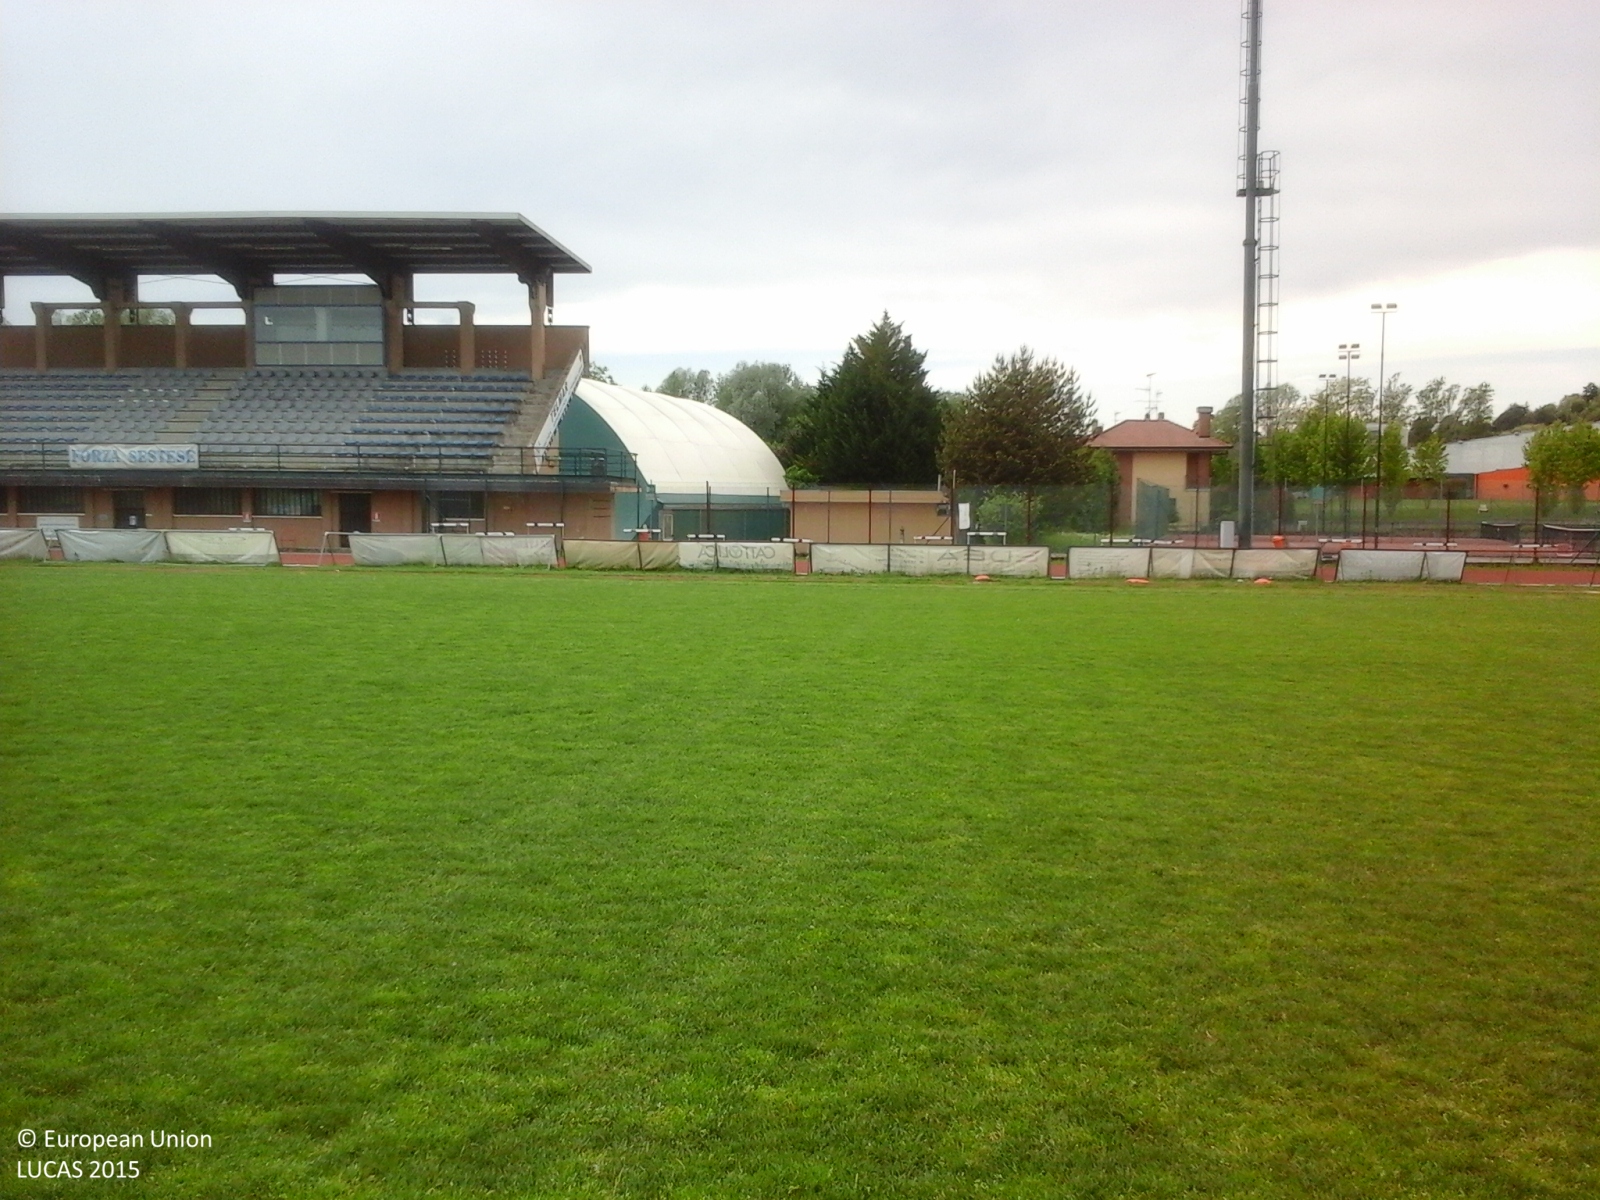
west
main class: Grassland
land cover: Grassland without tree/shrub cover
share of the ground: > 75 %
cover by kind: herbaceous plants 100 %
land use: Sport
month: May
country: IT
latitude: 45.7298
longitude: 8.6272
